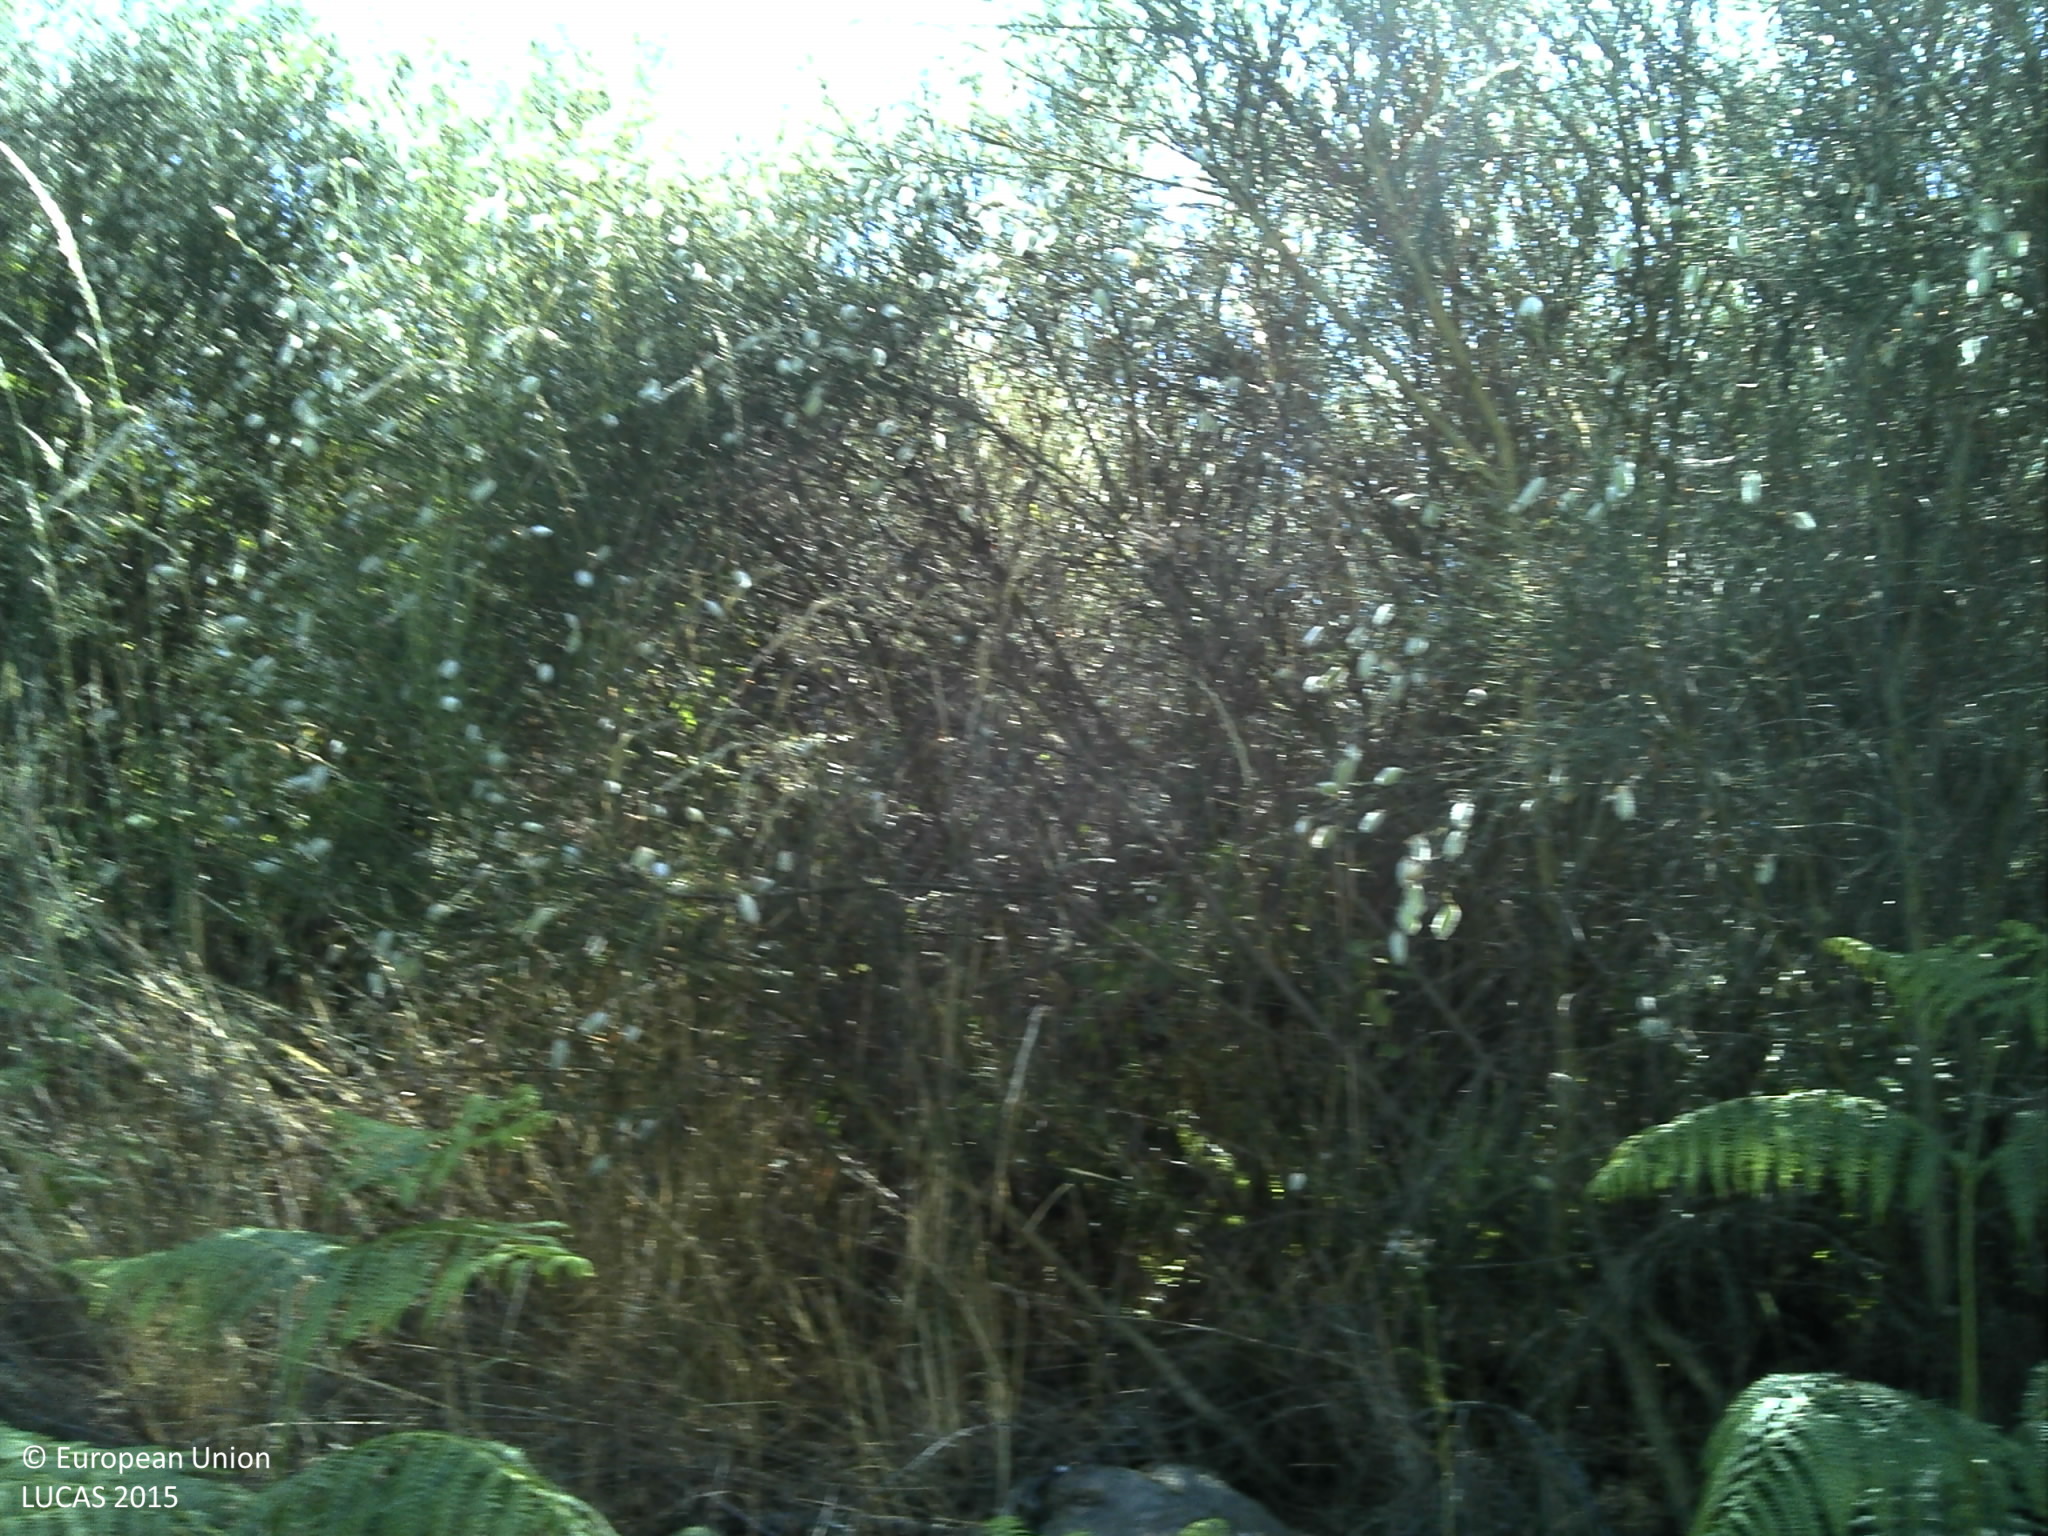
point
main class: Shrubland
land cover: Shrubland with sparse tree cover
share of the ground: > 75 %
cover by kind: shrubs 95 %, coniferous forest trees 5 %
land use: Semi-natural and natural areas not in use
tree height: > 5 m
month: June
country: PT
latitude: 41.0384
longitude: -7.5235
